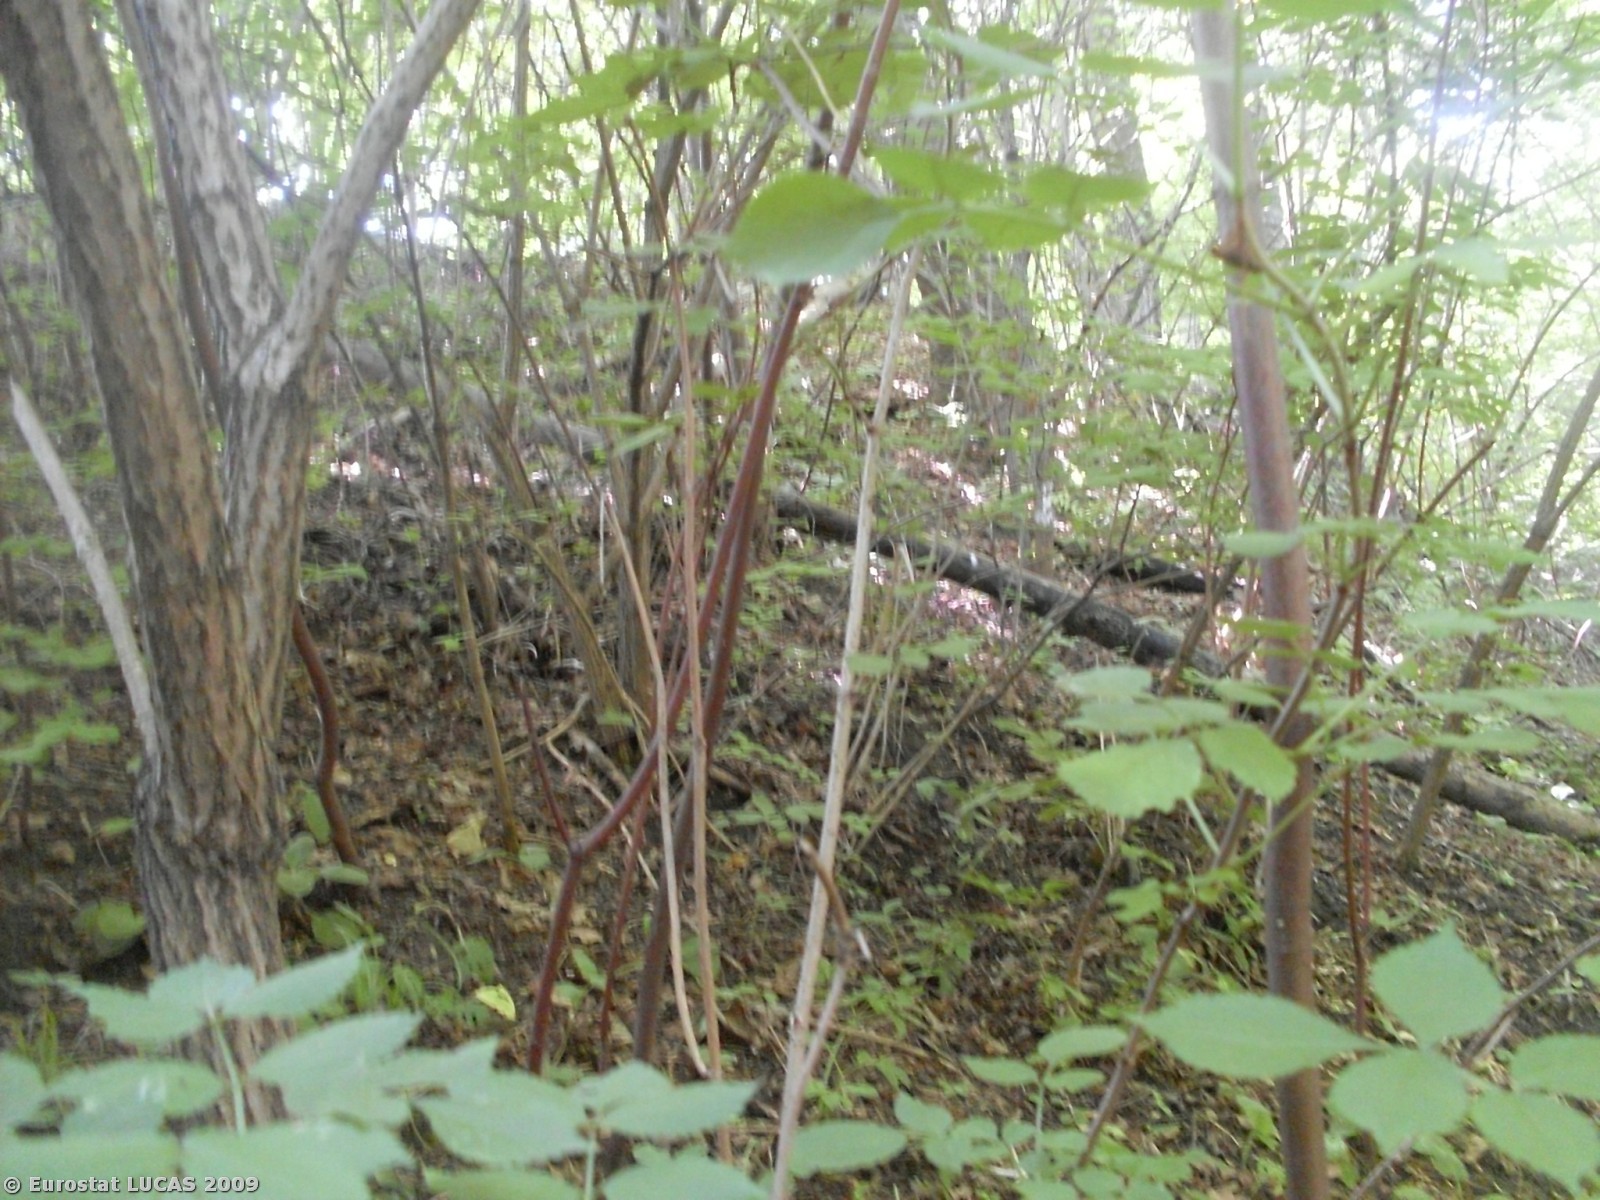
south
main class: Woodland
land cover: Broadleaved woodland
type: mesophytic deciduous forest
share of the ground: > 75 %
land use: Unused
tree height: > 5 m
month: July
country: PL
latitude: 49.7915
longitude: 20.2724
